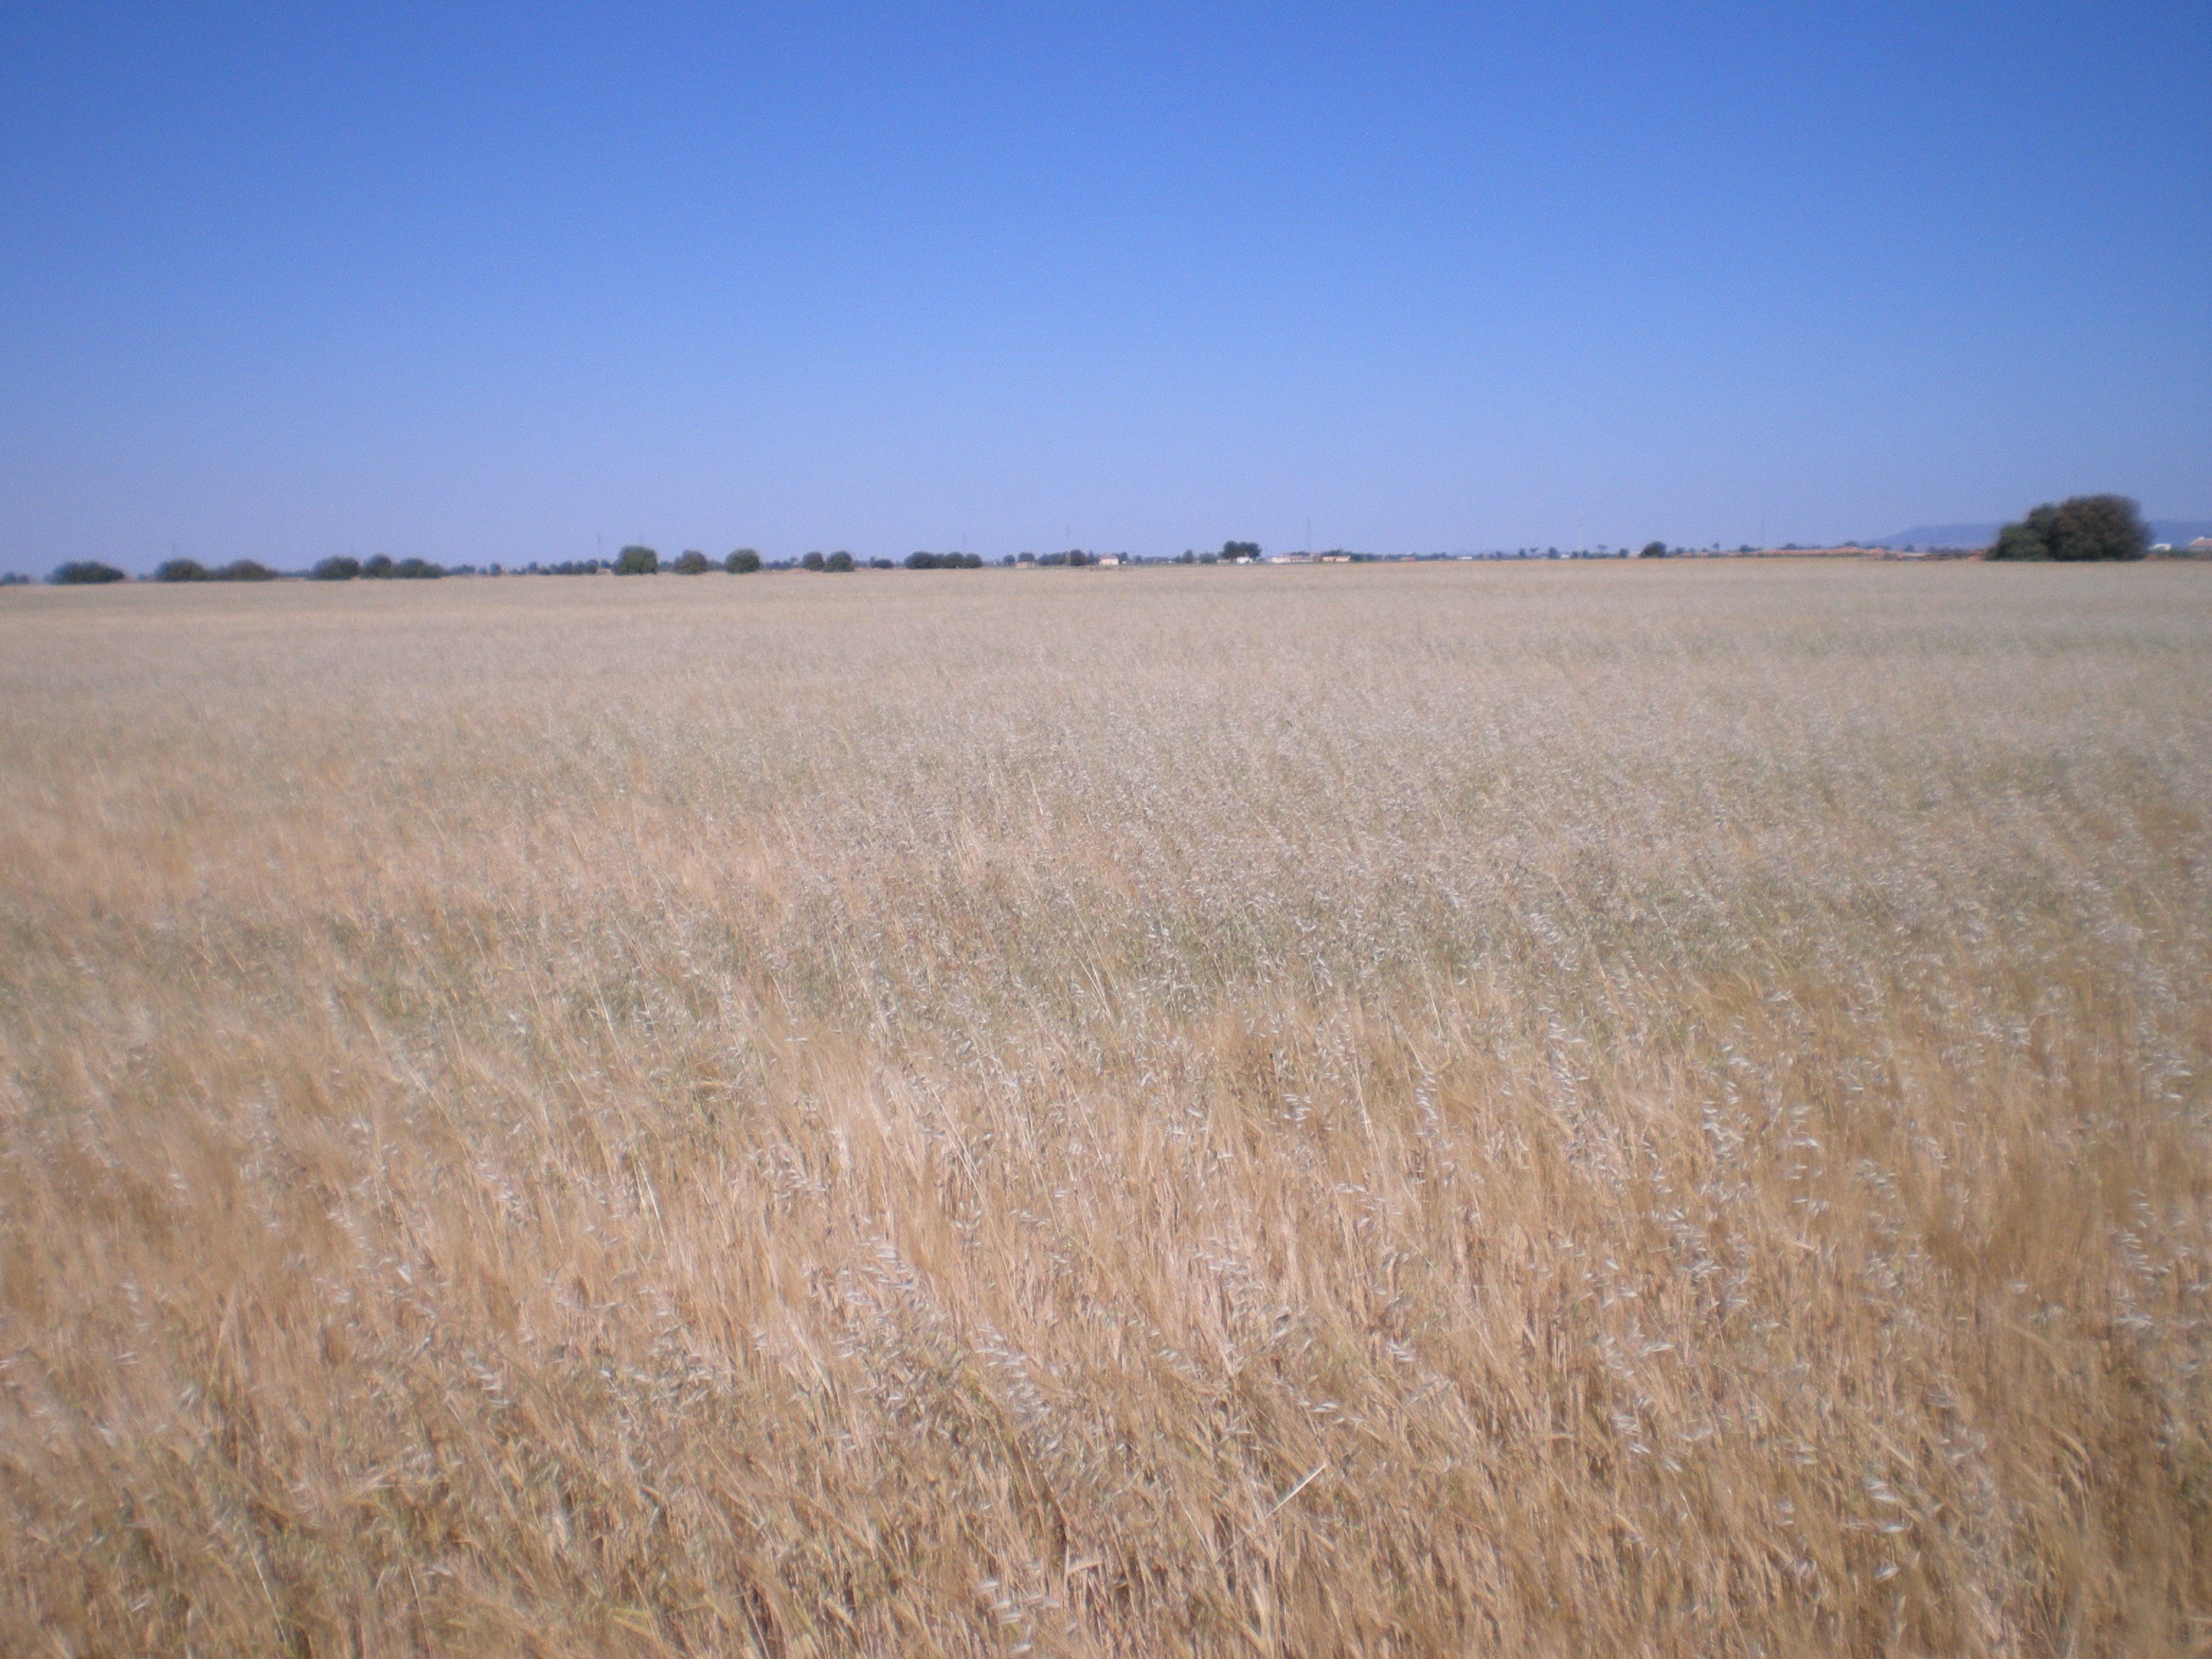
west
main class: Cropland
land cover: Barley
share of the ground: > 75 %
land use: Agriculture (excluding fallow land and kitchen gardens)
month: May
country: ES
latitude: 39.1071
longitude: -3.2554
